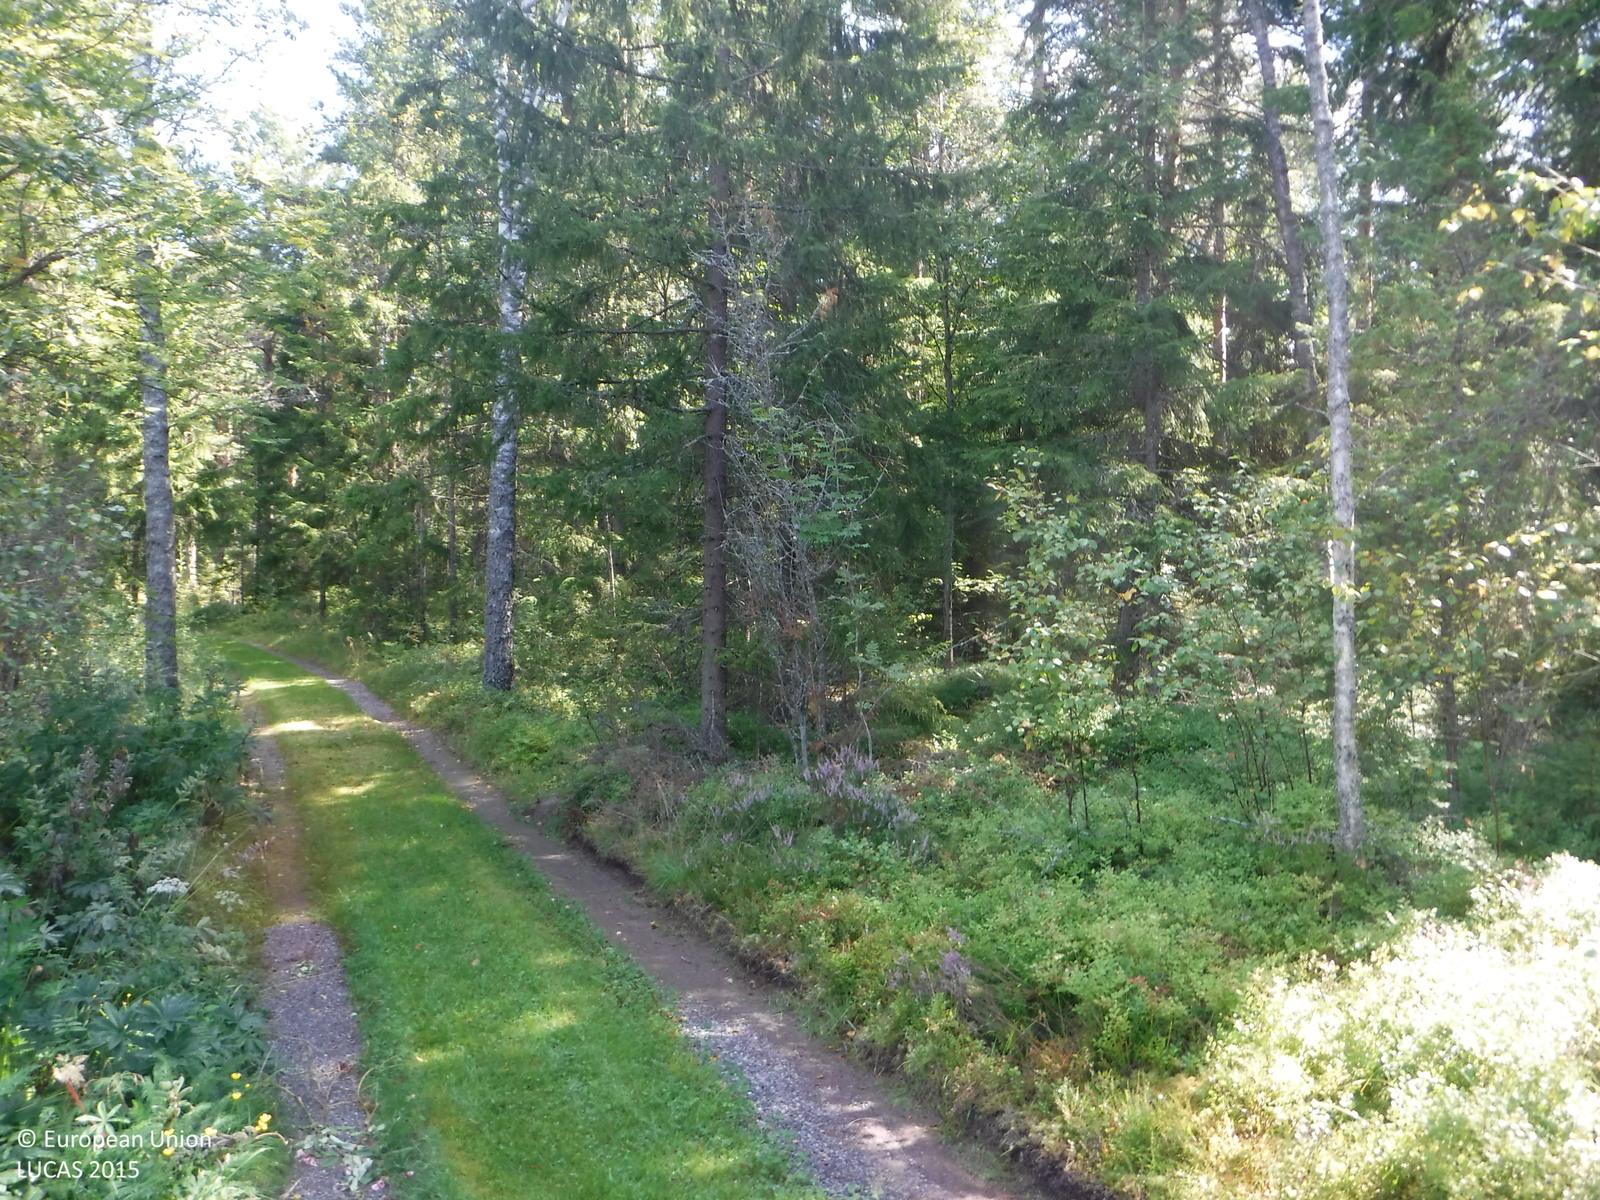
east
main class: Shrubland
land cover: Shrubland with sparse tree cover
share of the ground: 50 - 75 %
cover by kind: shrubs 60 %, herbaceous plants 25 %, consolidated bare surface 10 %, coniferous forest trees 5 %
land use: Amenities, museums, leisure
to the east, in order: Shrubland with sparse tree cover; Artificial constructions in urban areas; Pine dominated mixed woodland; Tracks; Pine dominated coniferous woodland; Electric lines; Tracks; Groves; Pine dominated coniferous woodland; Other mixed woodland; Pine dominated mixed woodland; Ditches and canals; Pine dominated mixed woodland
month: August
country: FI
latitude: 61.1622
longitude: 21.5578
